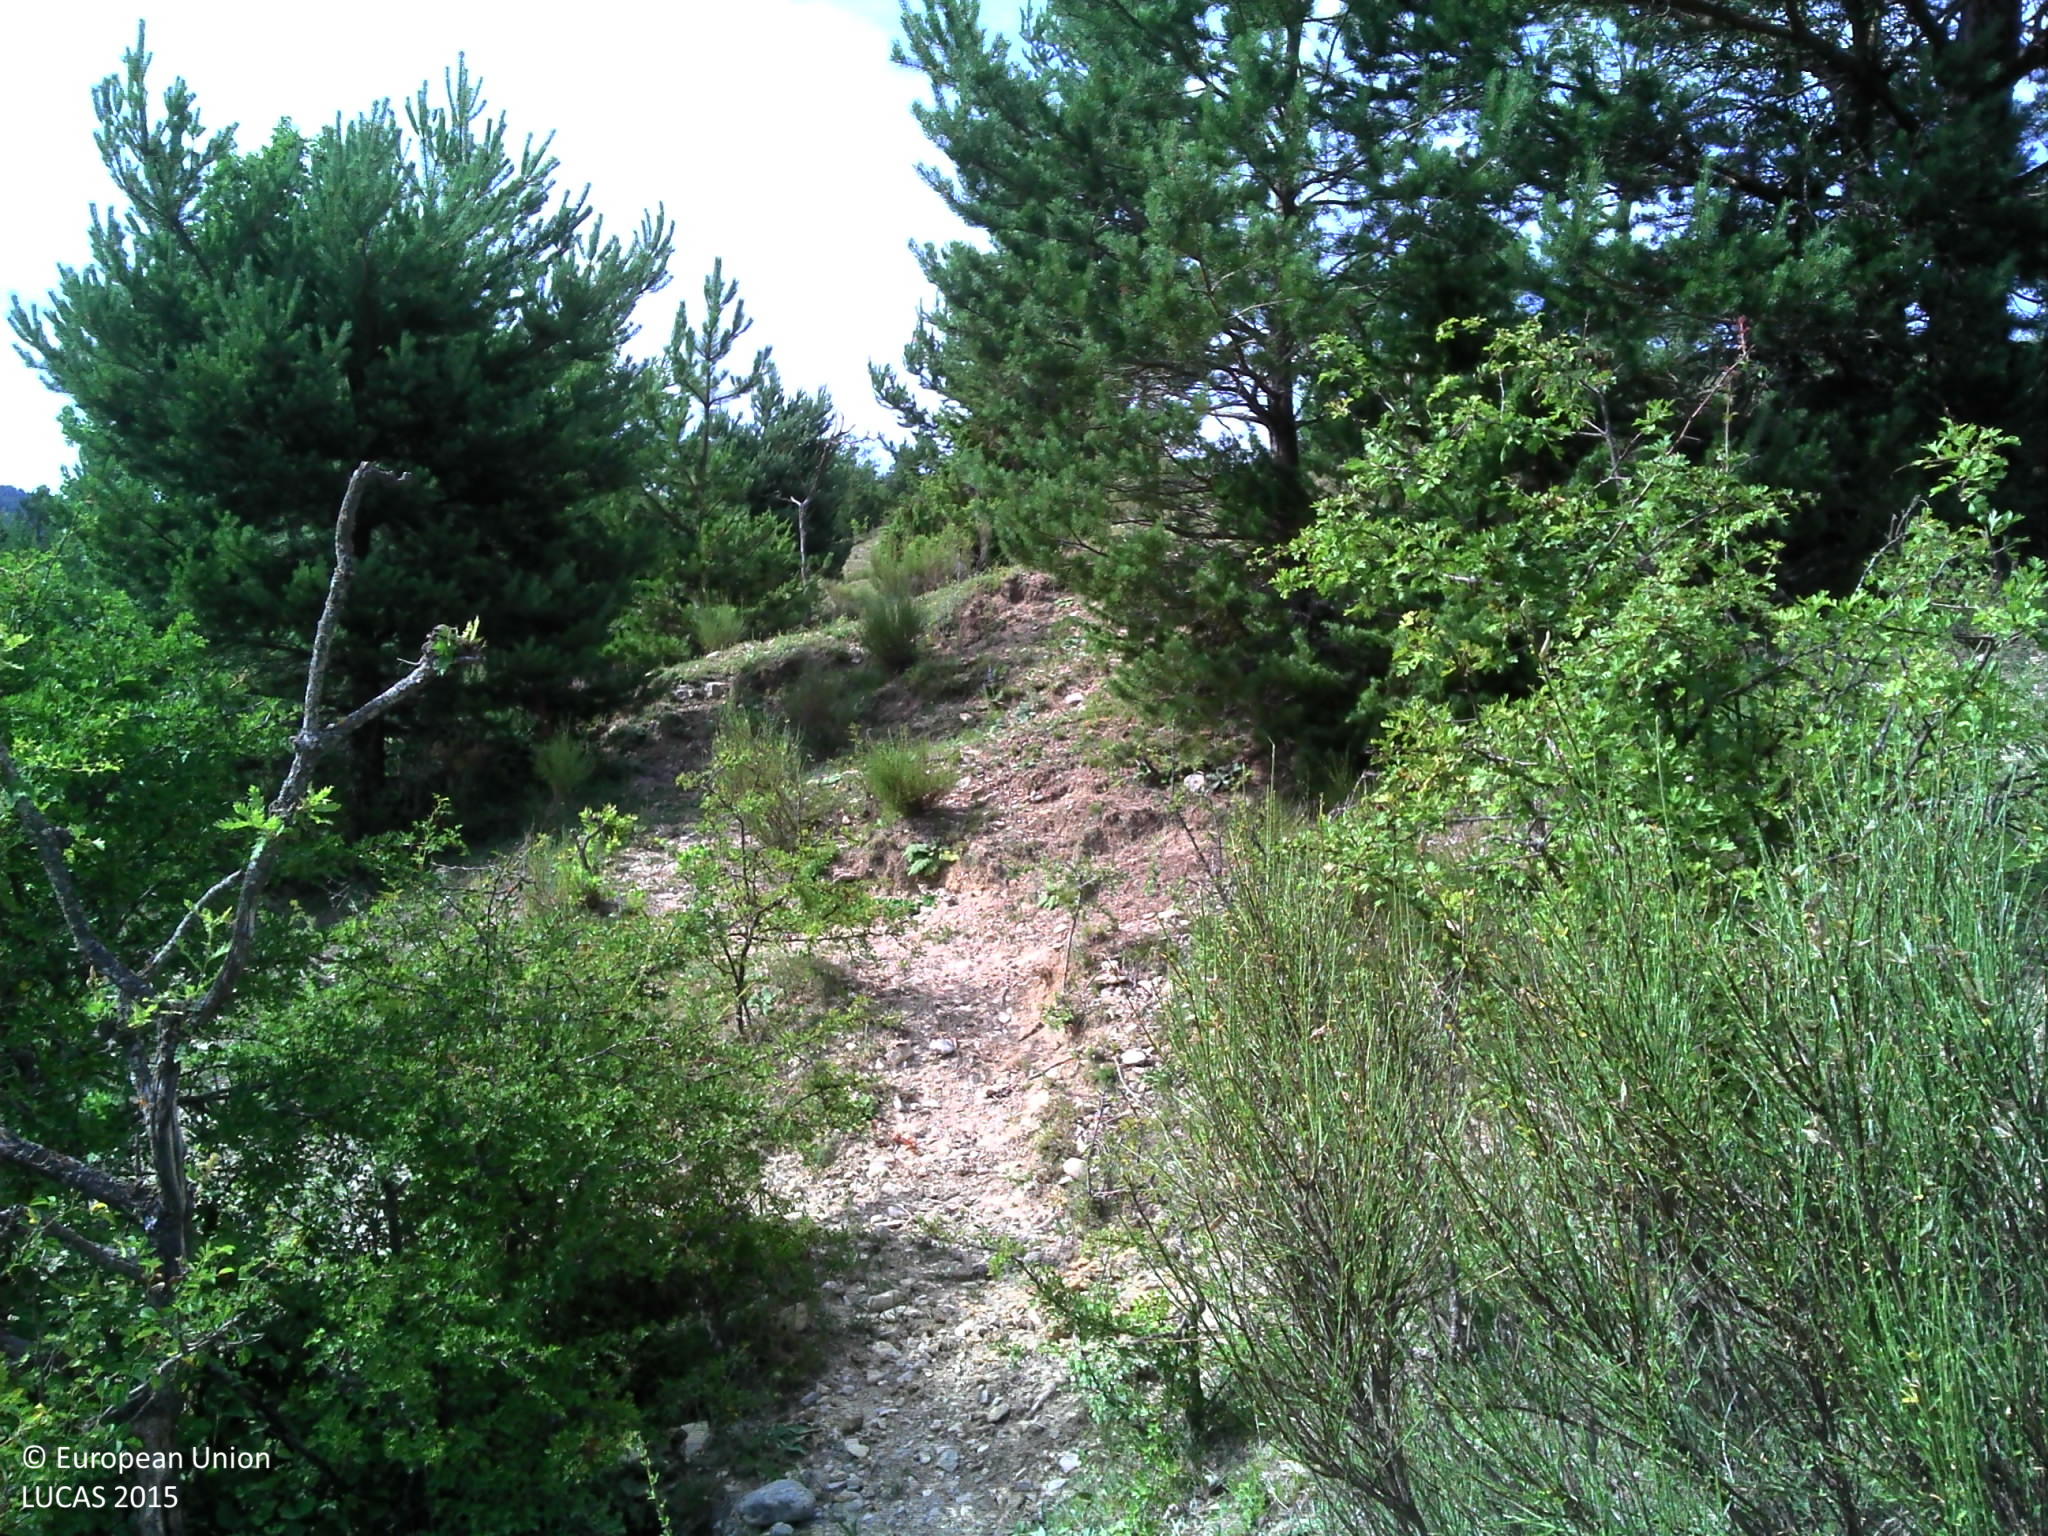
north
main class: Shrubland
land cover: Shrubland with sparse tree cover
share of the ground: > 75 %
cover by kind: shrubs 50 %, consolidated bare surface 35 %, herbaceous plants 10 %, broadleaved forest trees 5 %
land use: Agriculture (excluding fallow land and kitchen gardens)
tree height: > 5 m
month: July
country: FR
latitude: 43.9445
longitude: 6.3820
